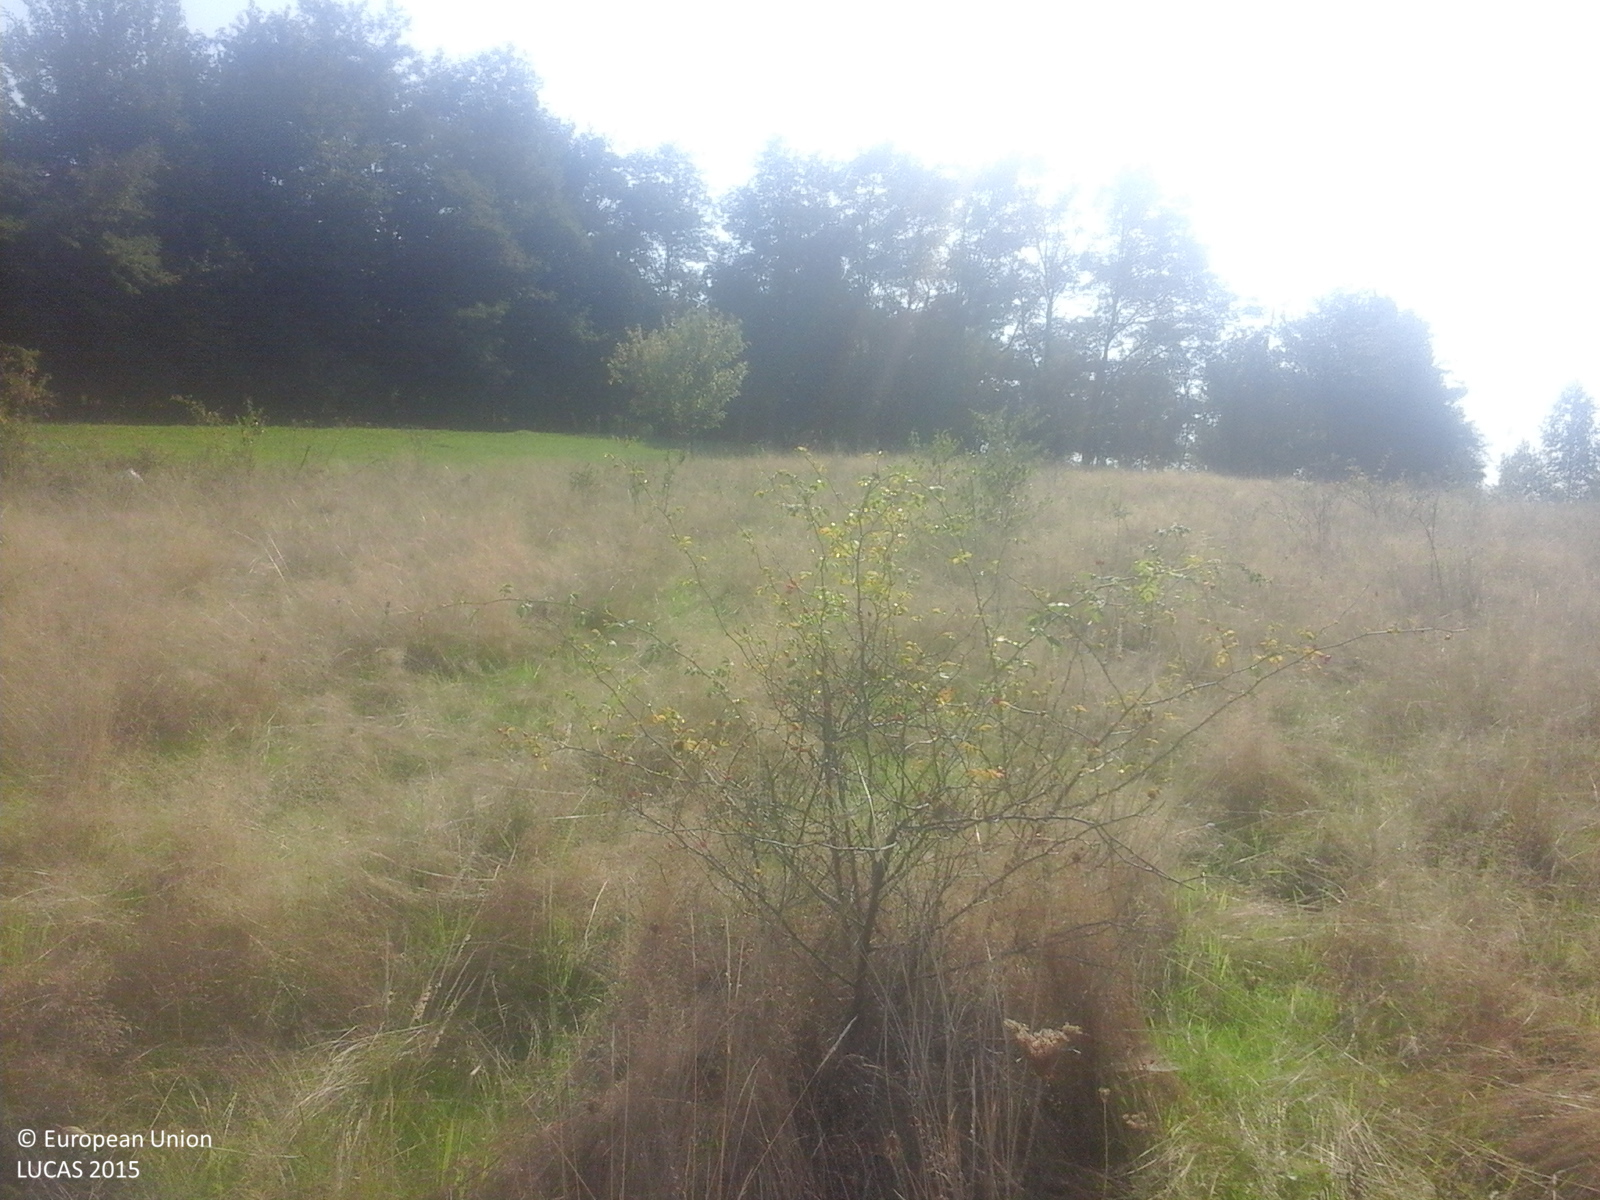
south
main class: Grassland
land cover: Grassland with sparse tree/shrub cover
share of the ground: > 75 %
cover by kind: herbaceous plants 85 %, shrubs 10 %, broadleaved forest trees 5 %
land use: Agriculture (excluding fallow land and kitchen gardens)
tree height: < 5 m
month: September
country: RO
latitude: 45.8514
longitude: 22.5006
